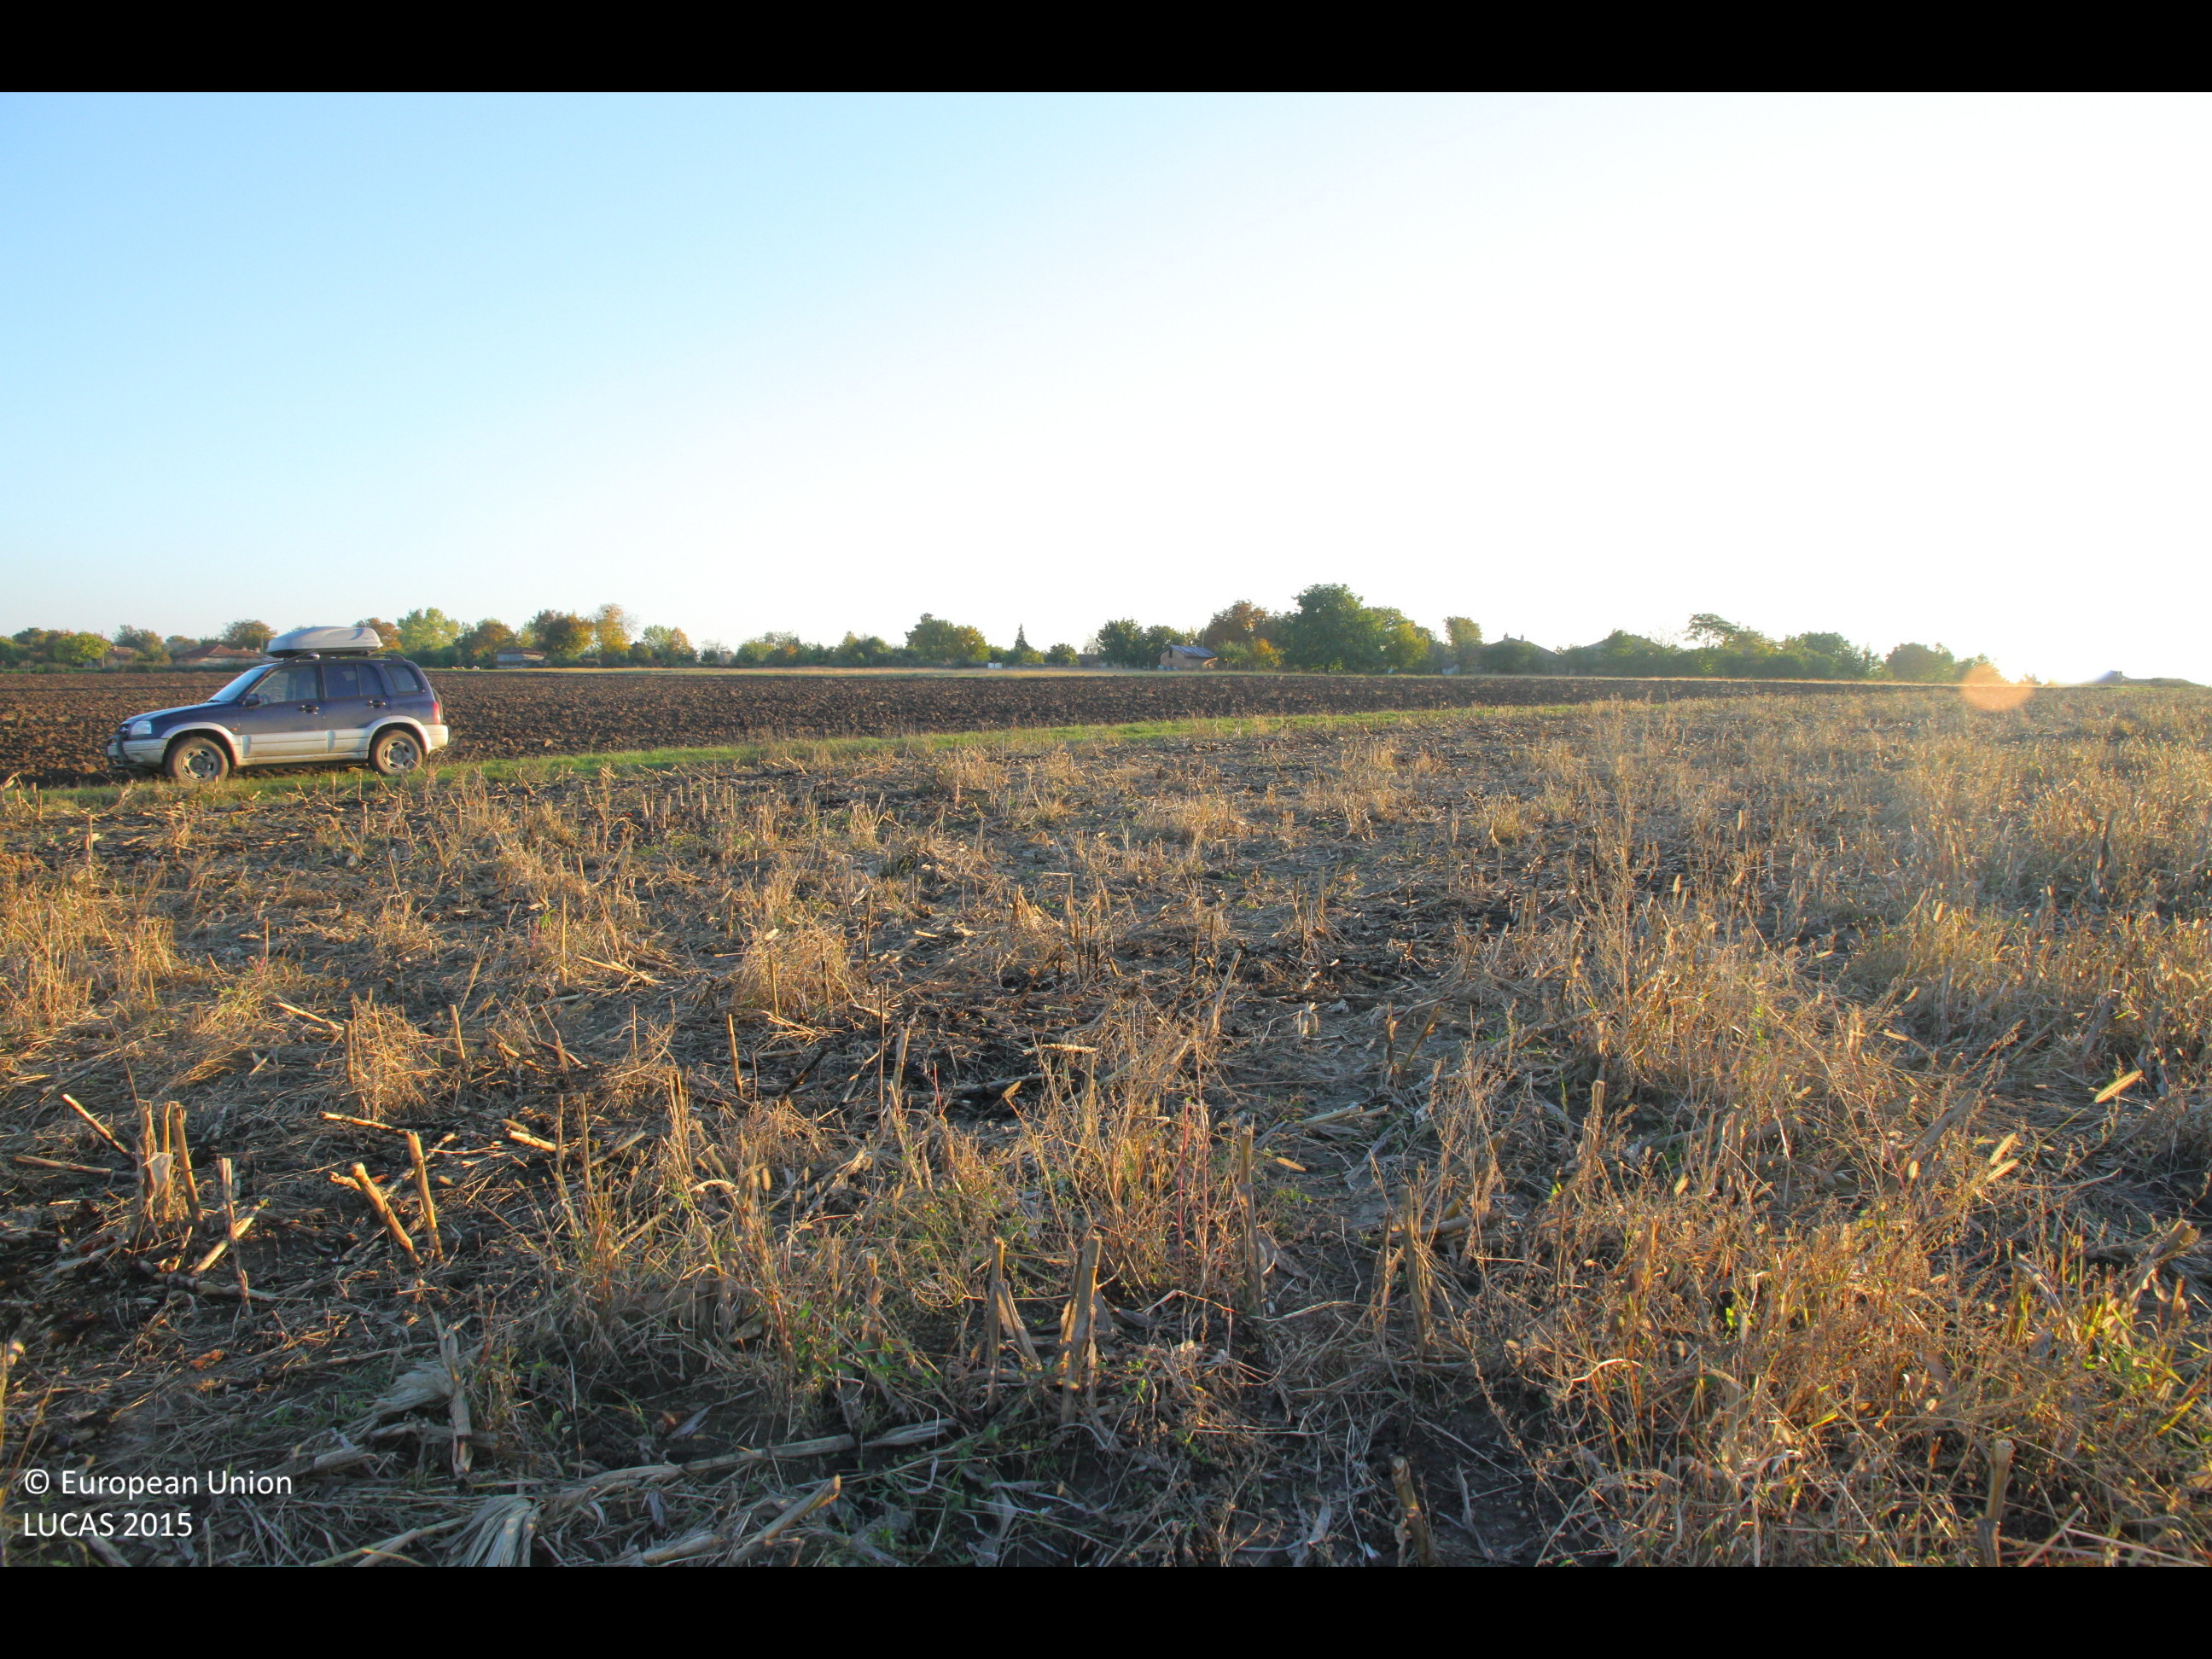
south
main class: Cropland
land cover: Maize
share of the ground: 10 - 25 %
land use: Agriculture (excluding fallow land and kitchen gardens)
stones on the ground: < 10 %
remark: Harvested field
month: October
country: BG
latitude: 43.7069
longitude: 26.4496
